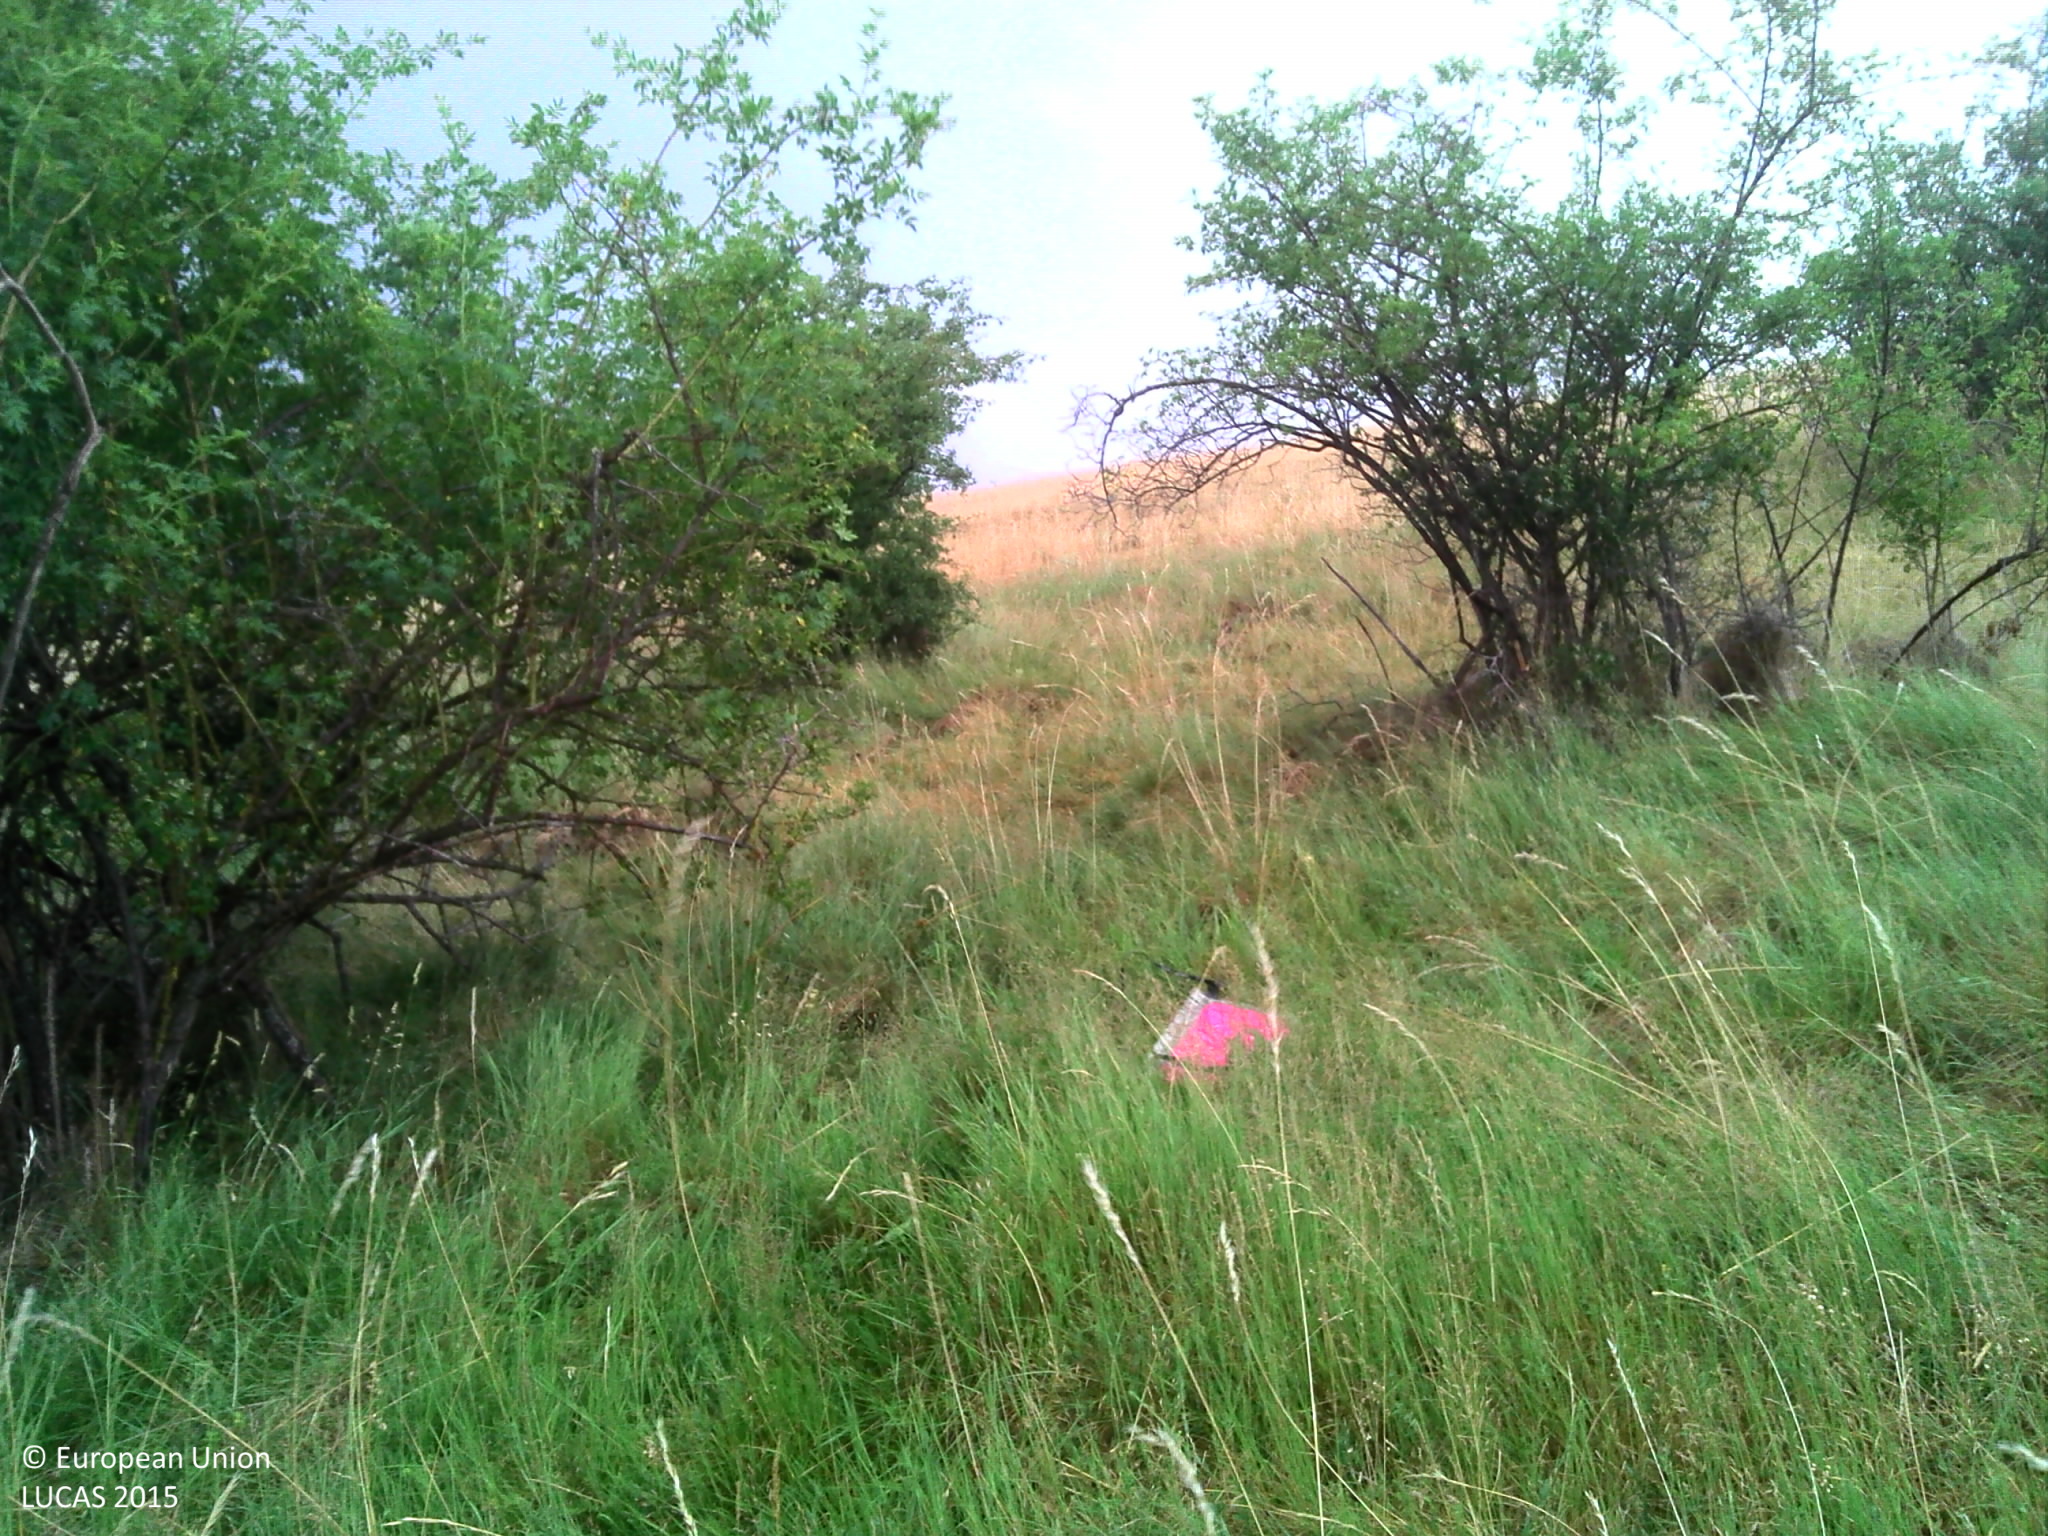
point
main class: Grassland
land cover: Grassland with sparse tree/shrub cover
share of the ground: > 75 %
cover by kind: herbaceous plants 85 %, shrubs 10 %, broadleaved forest trees 5 %
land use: Agriculture (excluding fallow land and kitchen gardens)
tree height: < 5 m
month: July
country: FR
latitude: 42.4780
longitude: 1.9460
